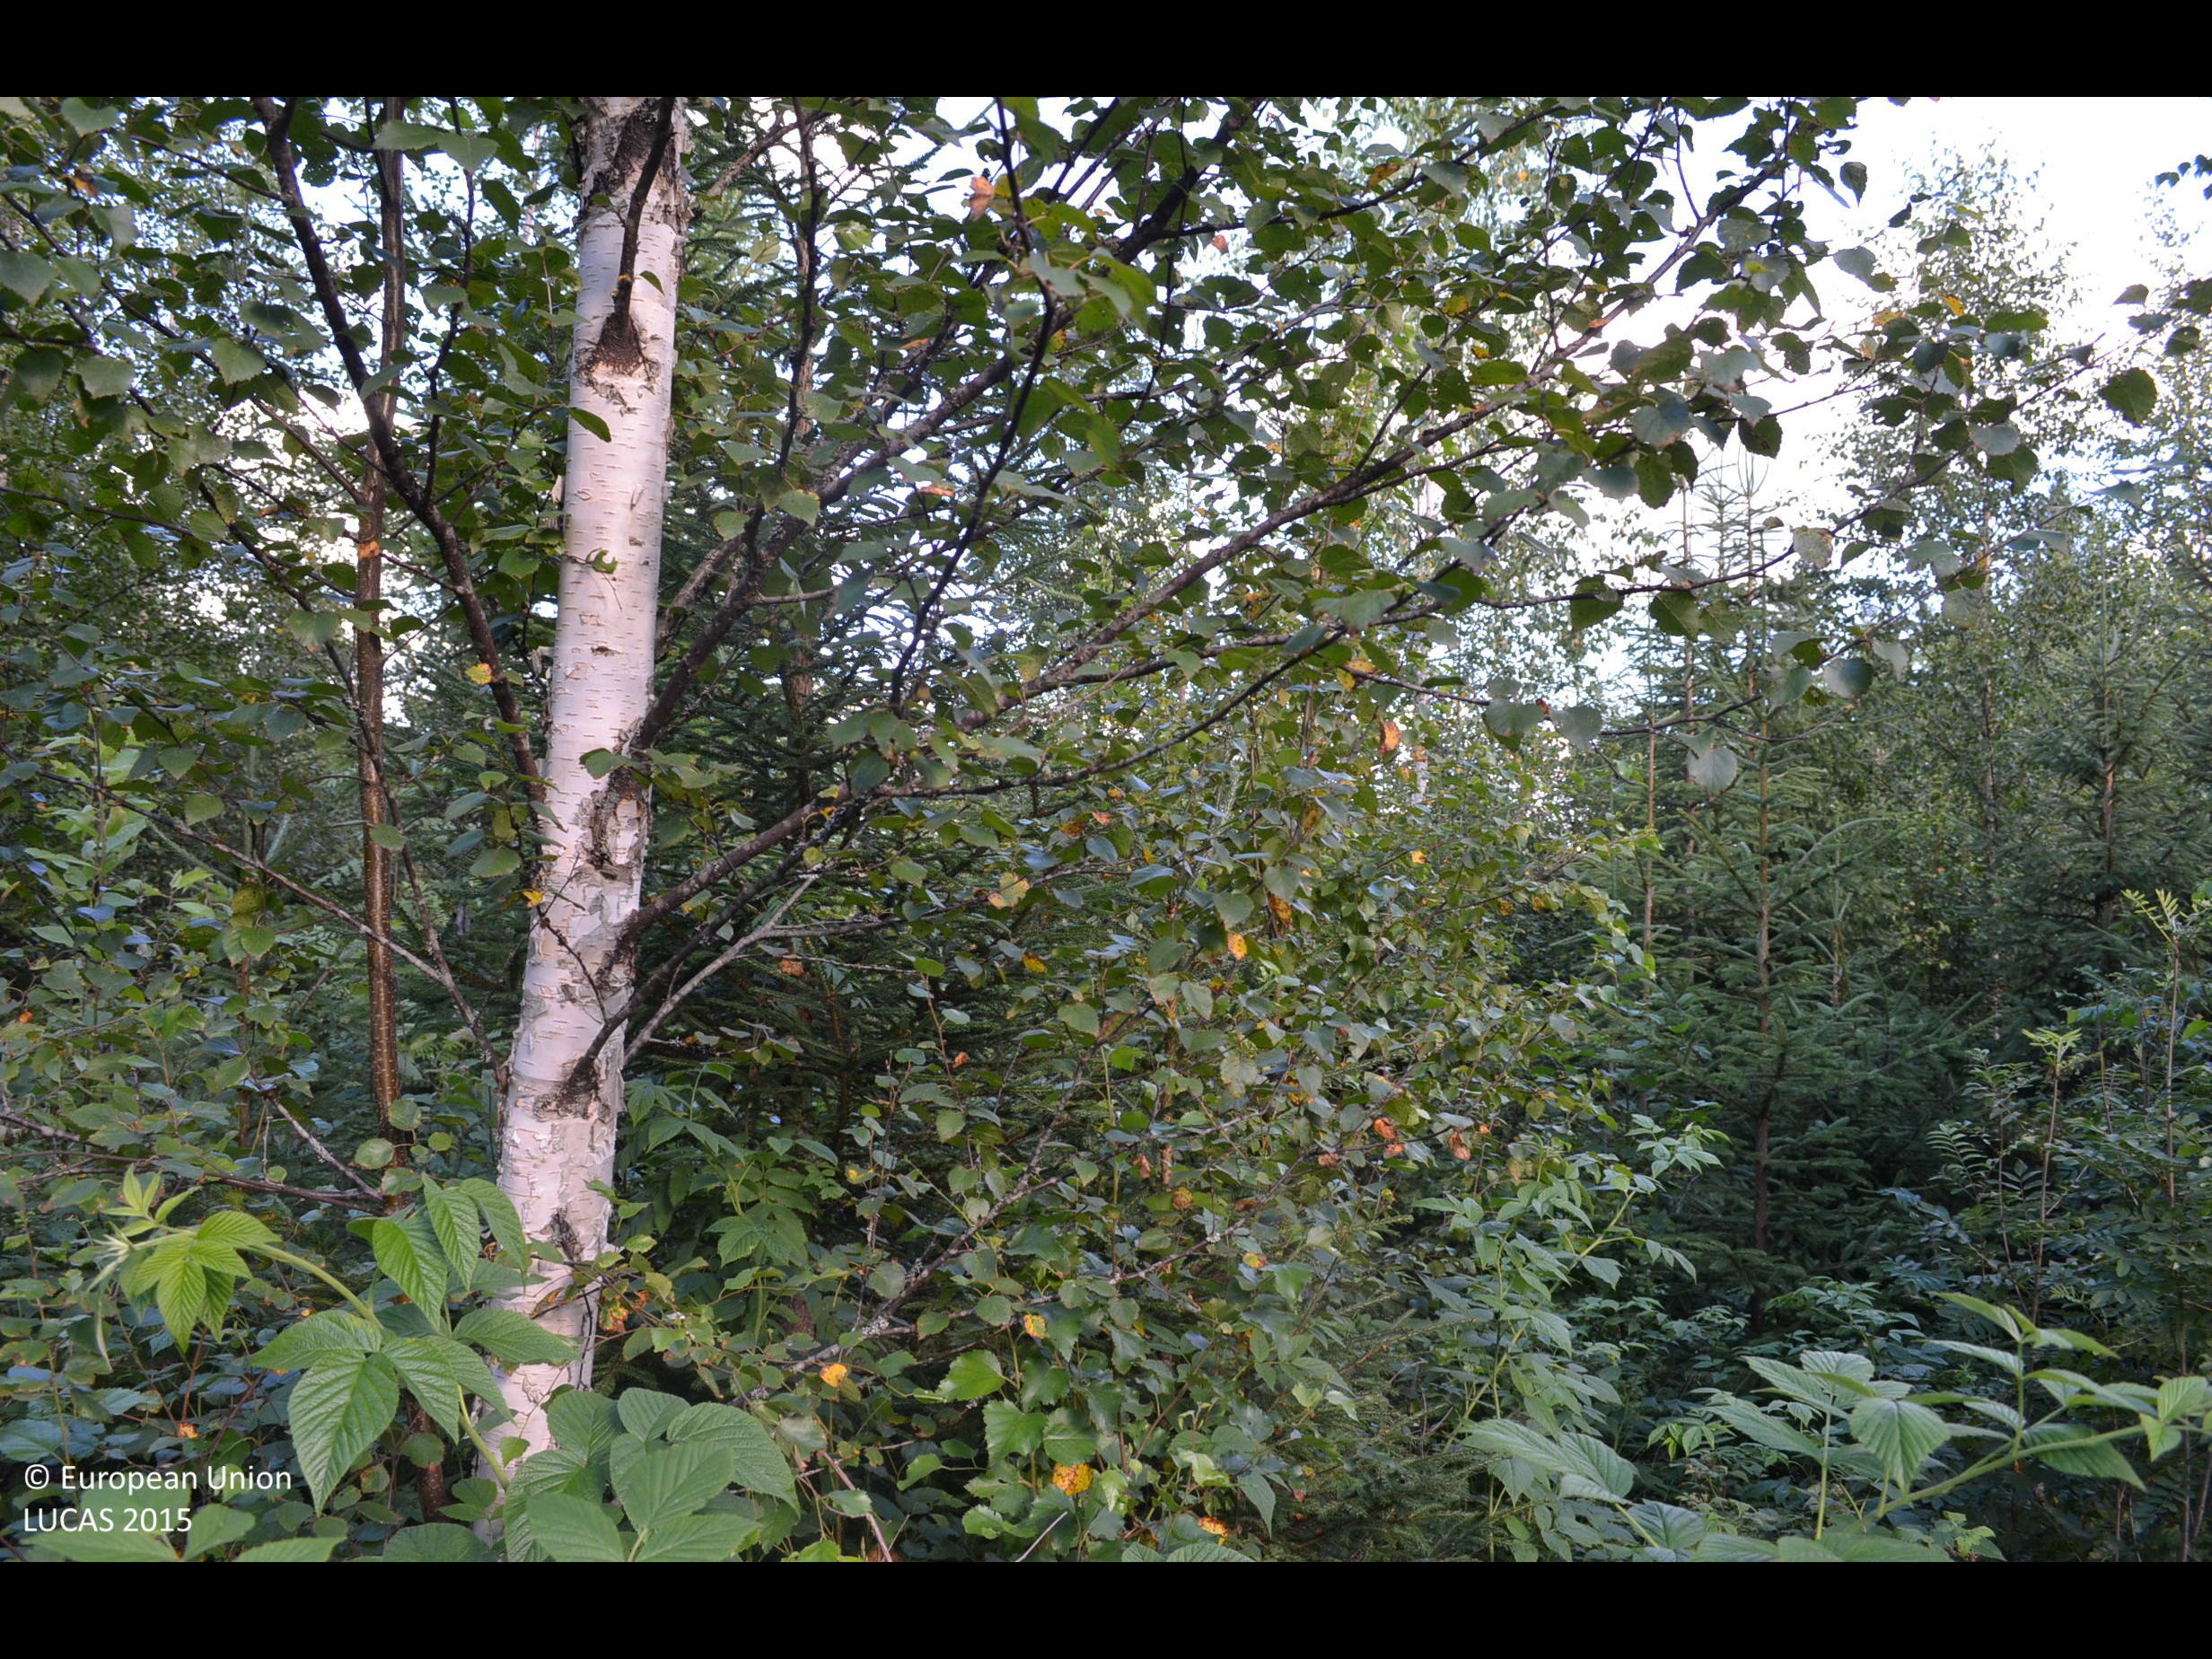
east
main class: Woodland
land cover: Spruce dominated mixed woodland
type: boreal forest
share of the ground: > 75 %
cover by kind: broadleaved forest trees 40 %, coniferous forest trees 35 %, shrubs 20 %, herbaceous plants 5 %
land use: Forestry
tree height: < 5 m
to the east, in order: Spruce dominated mixed woodland; Ditches and canals; Grass margins; Tracks; Grass margins; Ditches and canals; Spruce dominated mixed woodland; Ditches and canals; Spruce dominated mixed woodland; Ditches and canals; Grass margins; Tracks; Grass margins; Ditches and canals; Other mixed woodland; Grass margins; Barley
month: August
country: FI
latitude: 61.5945
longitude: 23.1312
